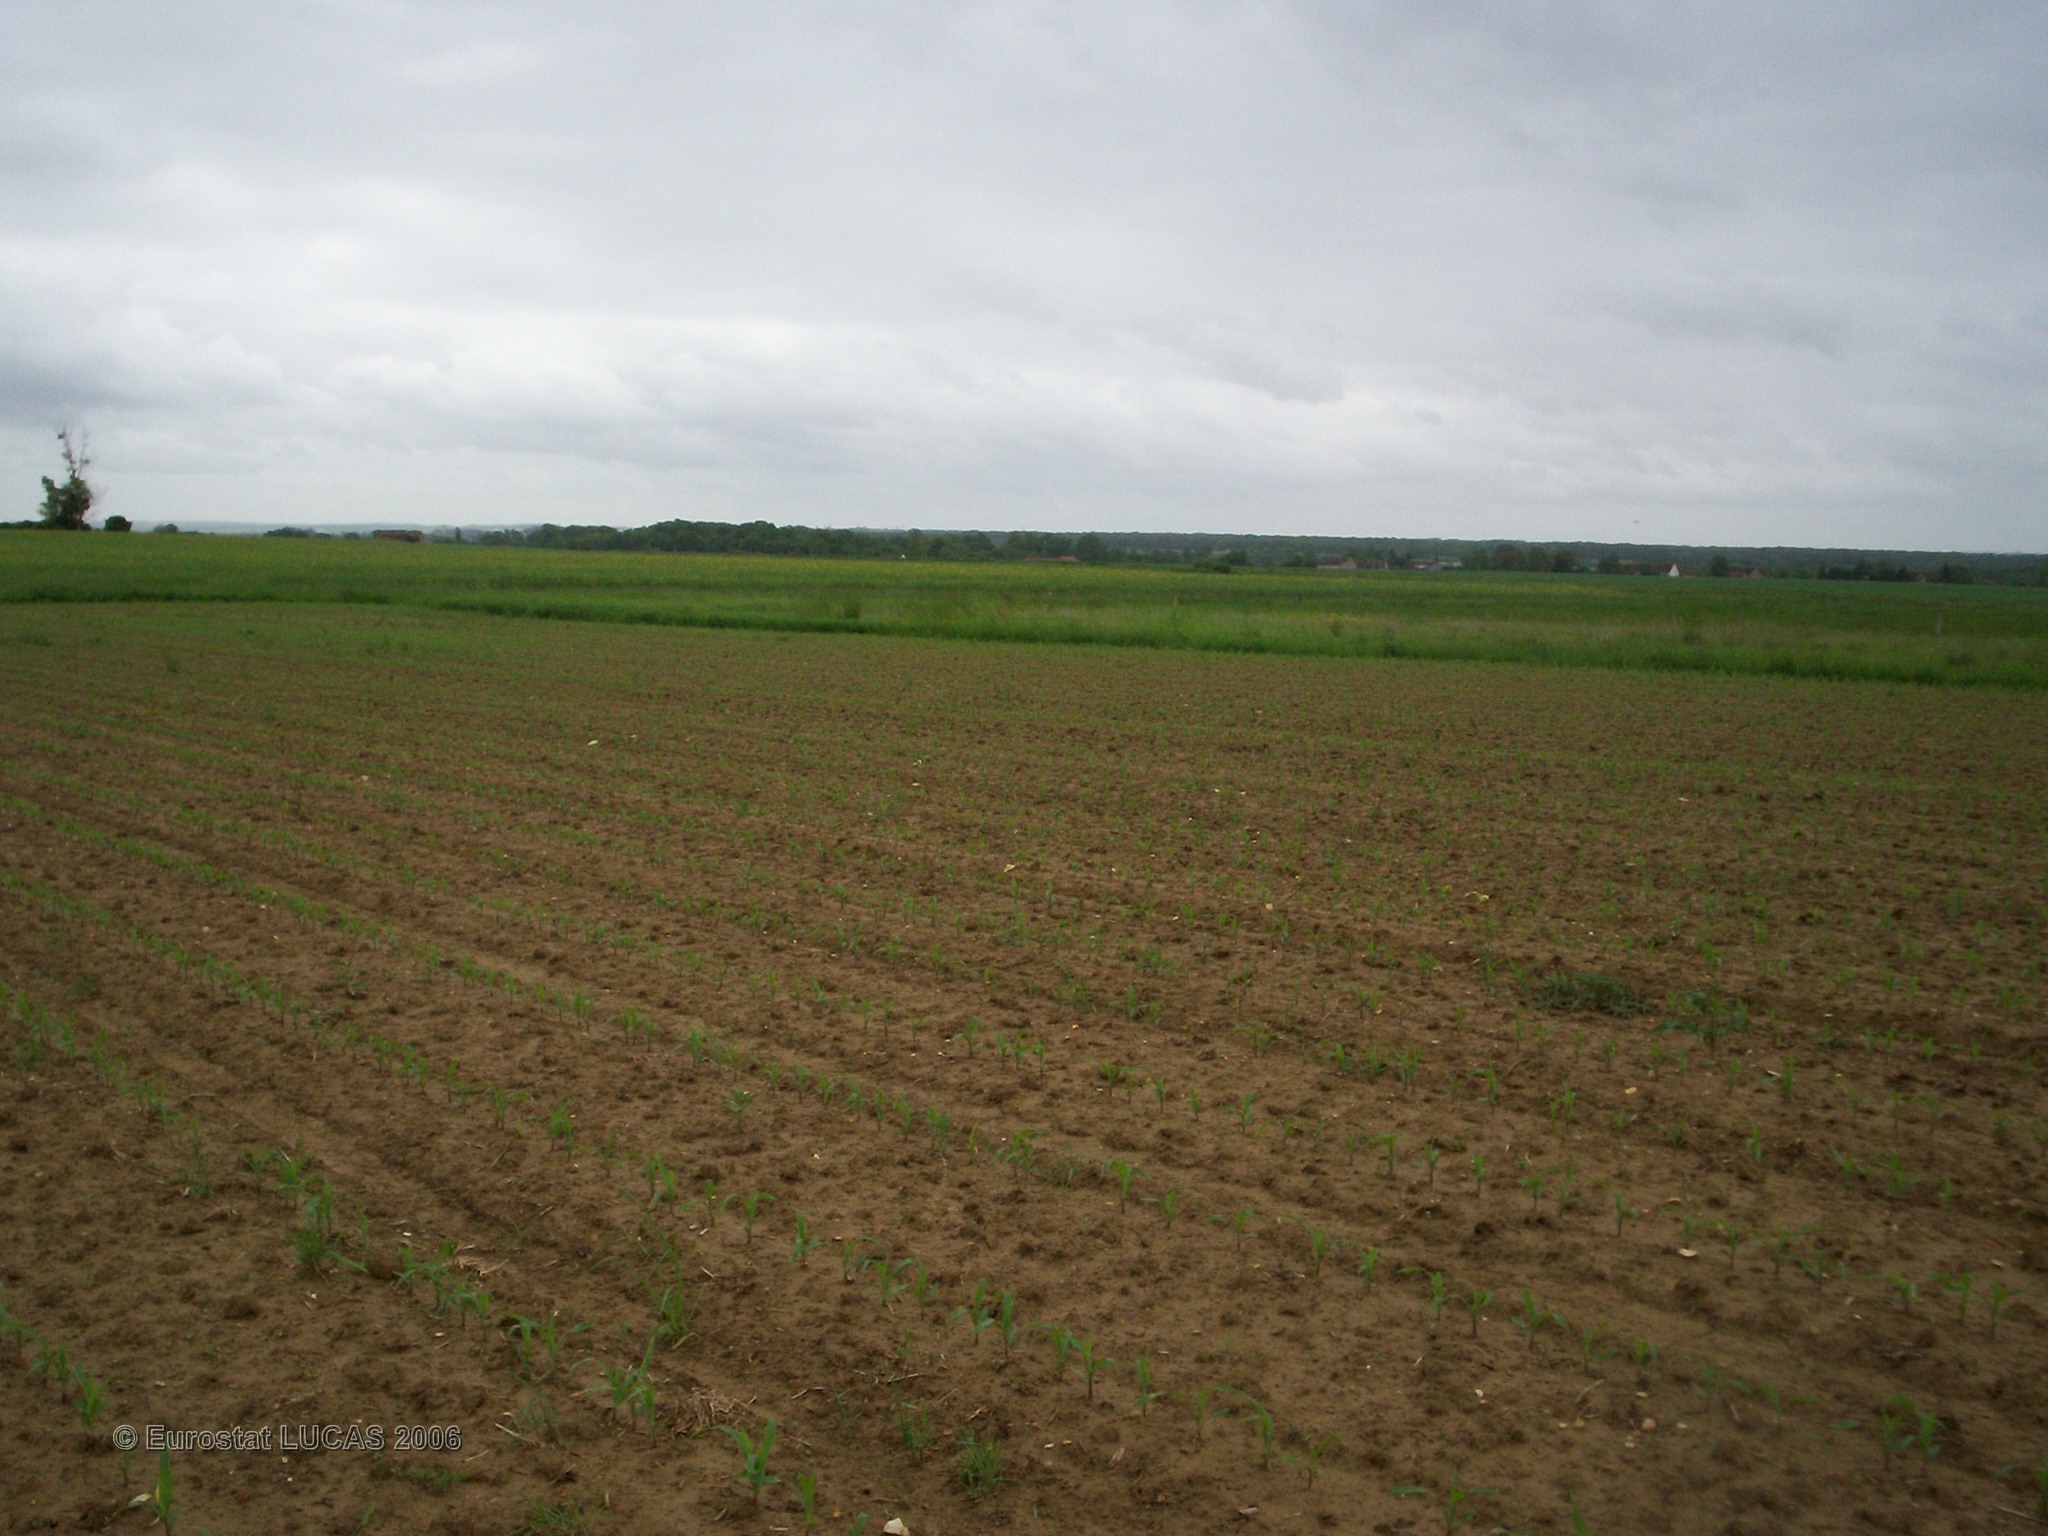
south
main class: Cropland
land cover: Maize
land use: Agriculture (excluding fallow land and kitchen gardens)
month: May
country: FR
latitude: 47.9780
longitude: 3.8202
